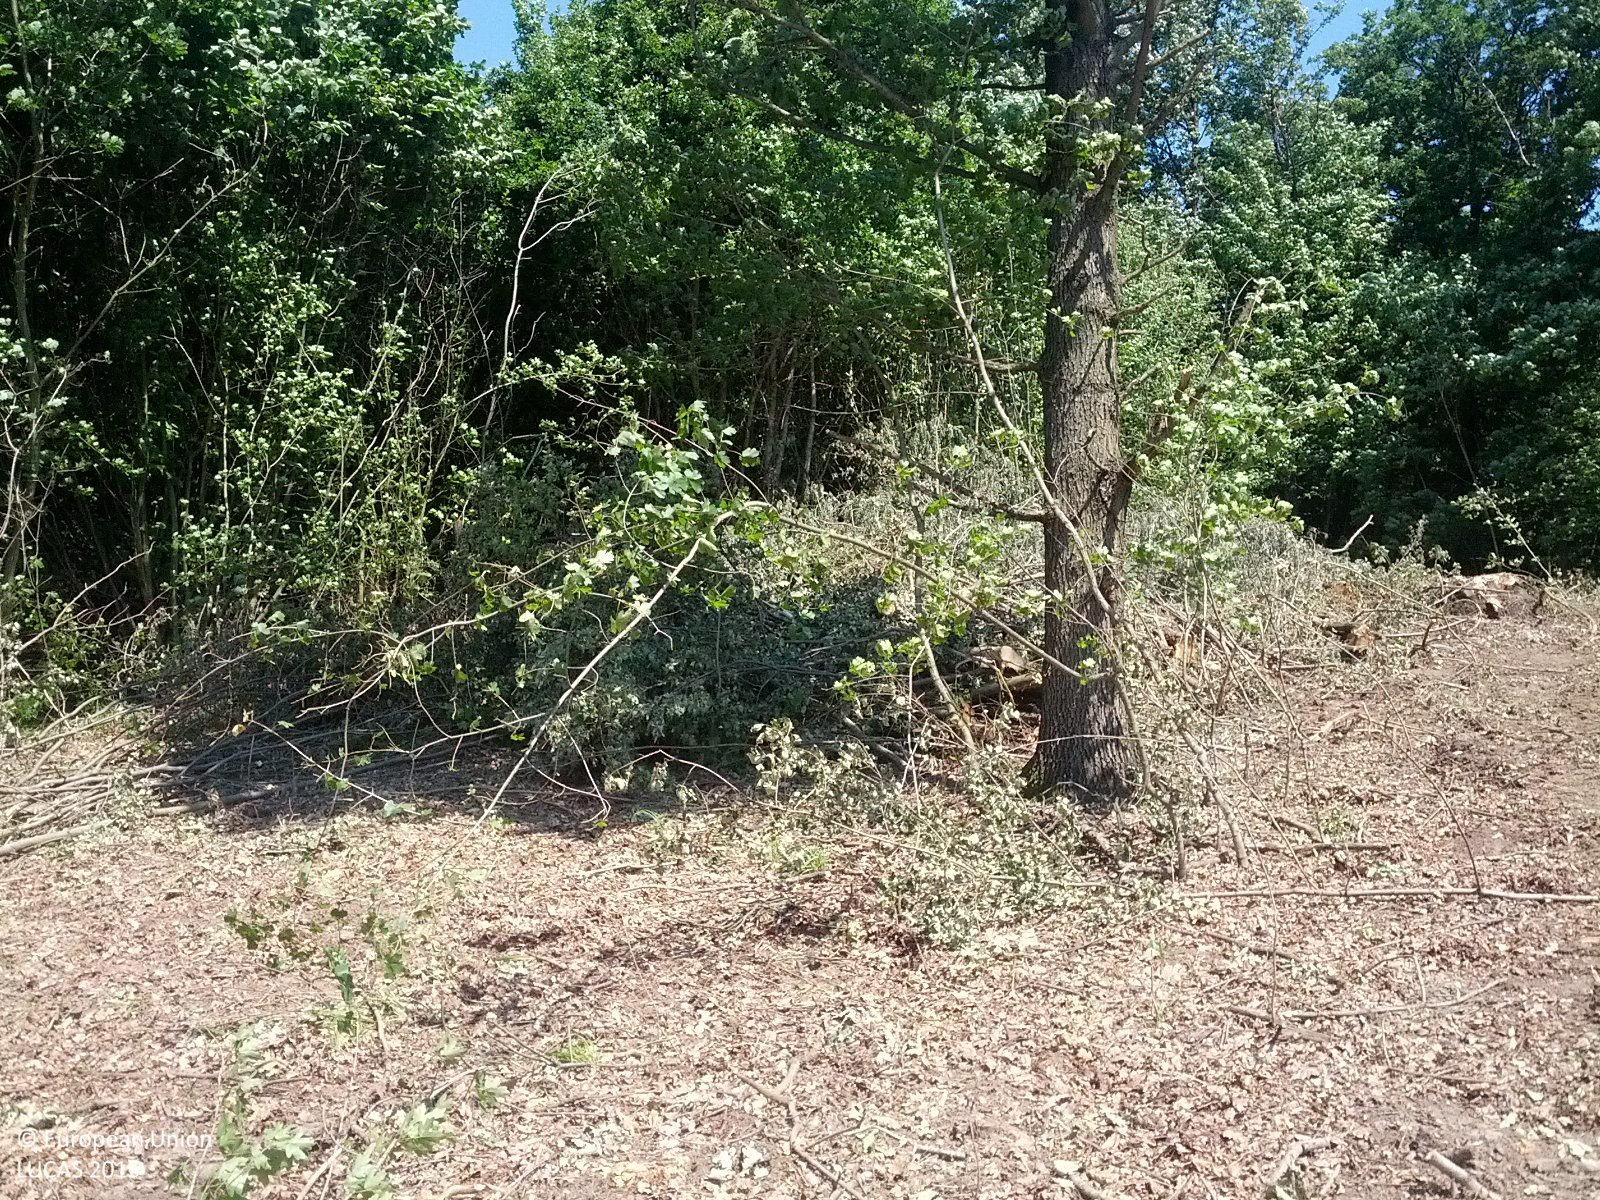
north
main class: Woodland
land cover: Broadleaved woodland
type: mesophytic deciduous forest
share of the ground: < 10 %
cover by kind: unconsolidated bare surface 90 %, broadleaved forest trees 10 %
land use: Forestry
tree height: > 5 m
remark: Clear cut
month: July
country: AT
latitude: 48.6239
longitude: 16.5592
